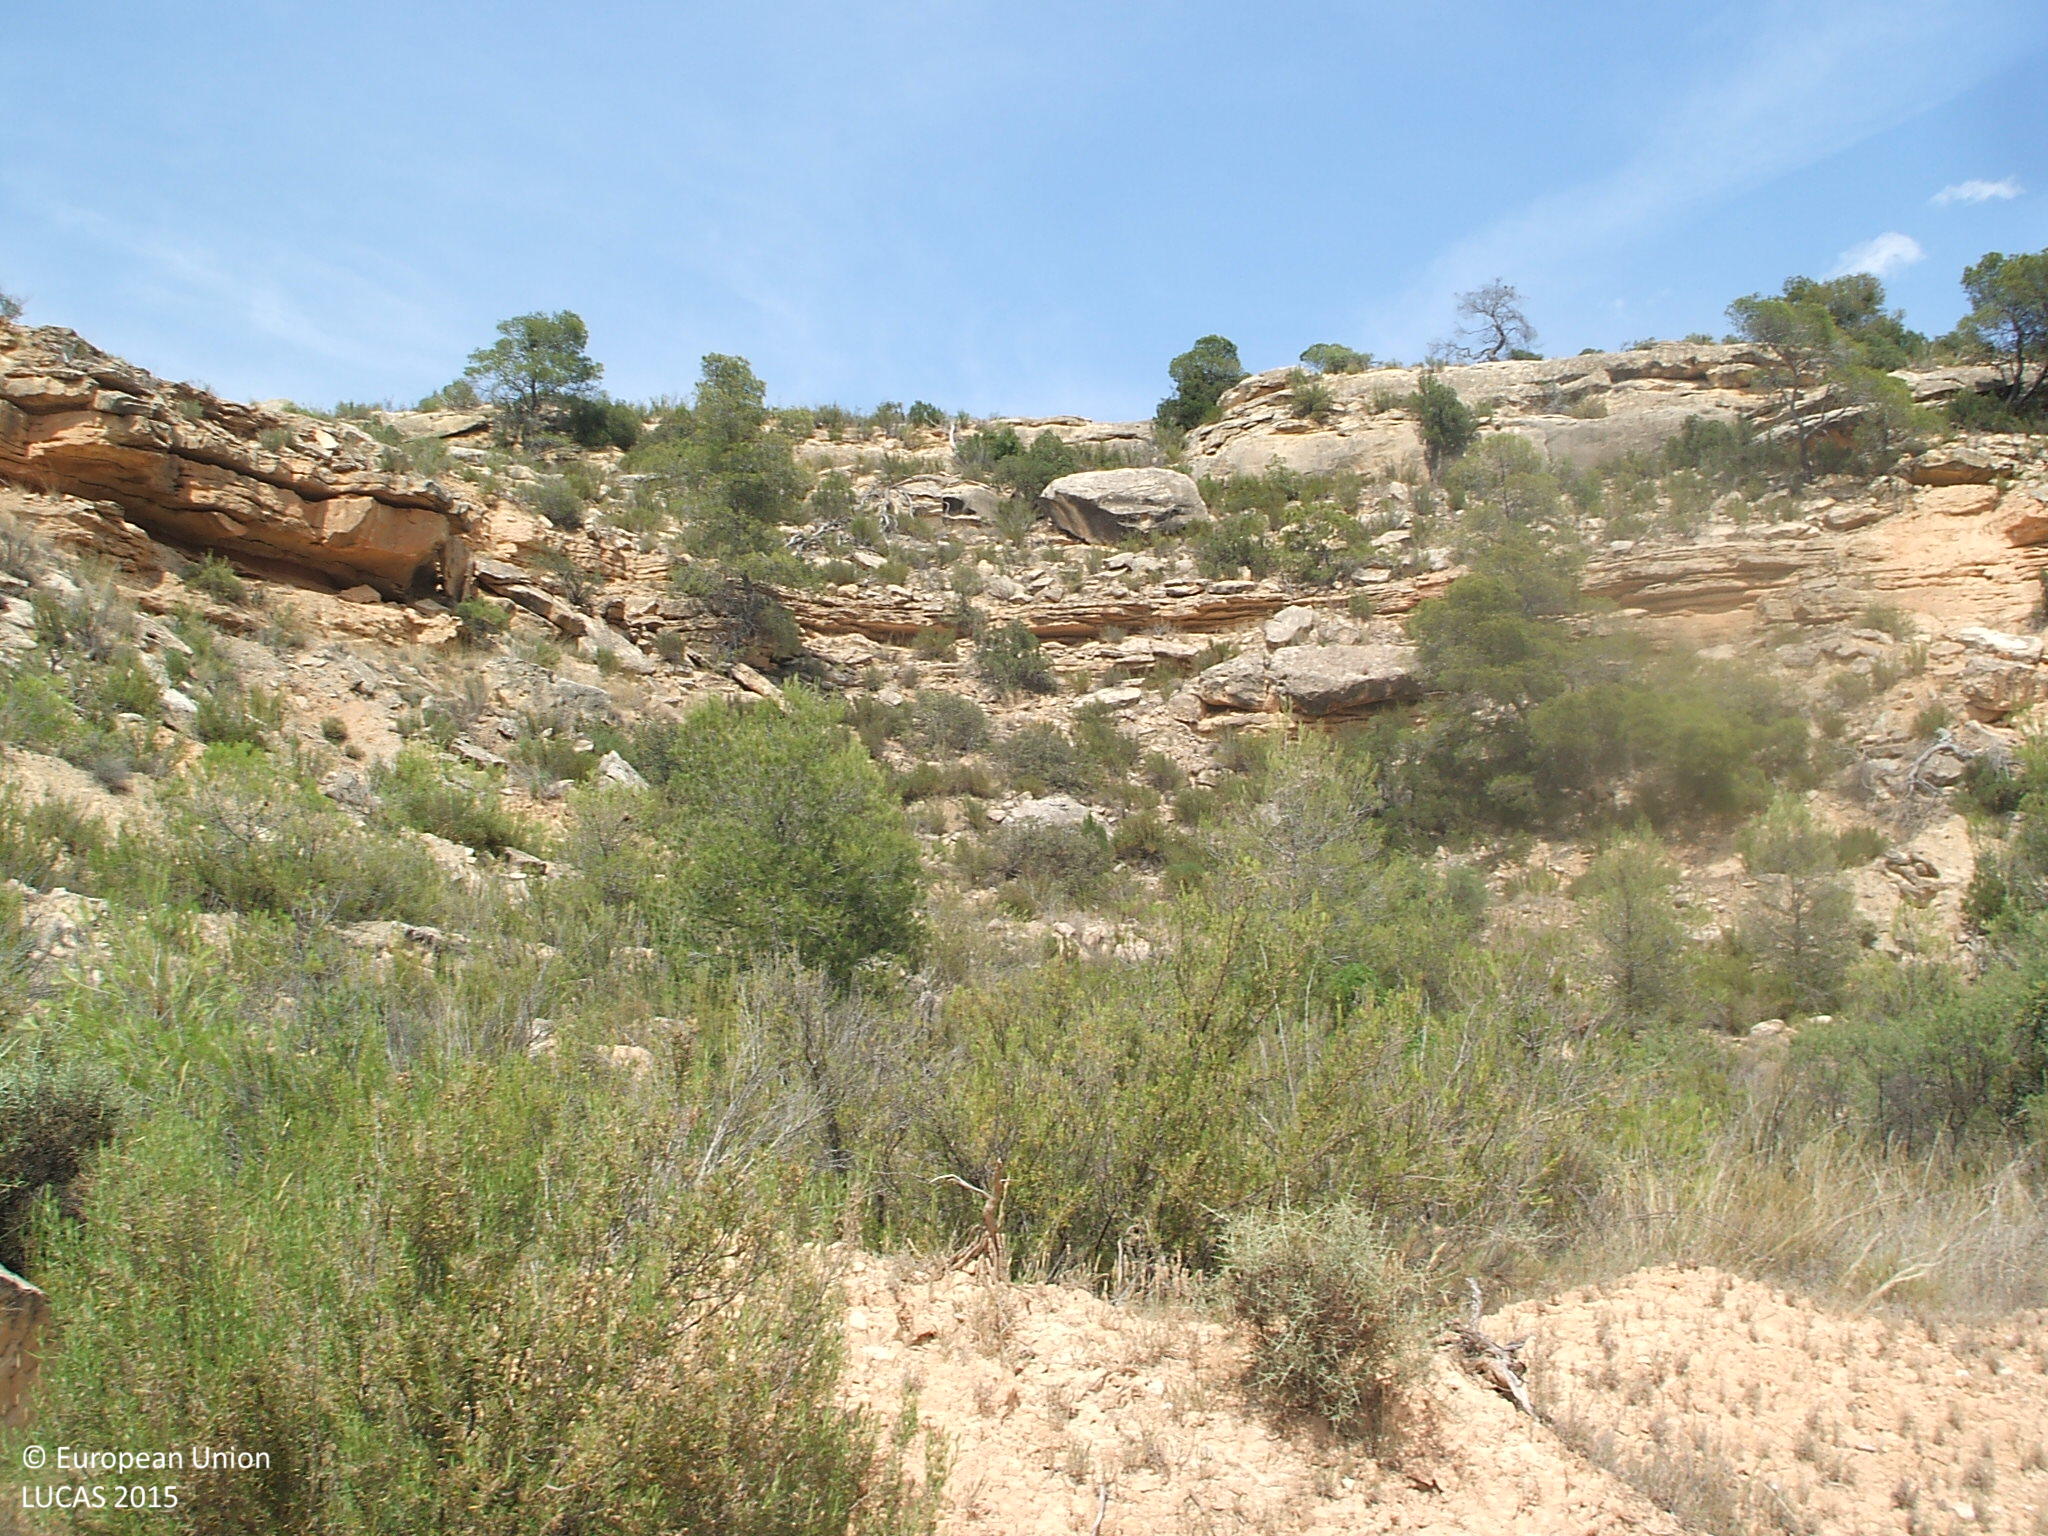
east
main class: Cropland
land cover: Nuts trees
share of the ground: < 10 %
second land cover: Other bare soil
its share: > 75 %
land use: Agriculture (excluding fallow land and kitchen gardens)
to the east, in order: Nuts trees; Other bare soil; Pine dominated coniferous woodland; Rock outcrops; Pine dominated coniferous woodland; Shrubland with sparse tree cover
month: June
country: ES
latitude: 41.1003
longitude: -0.0247
